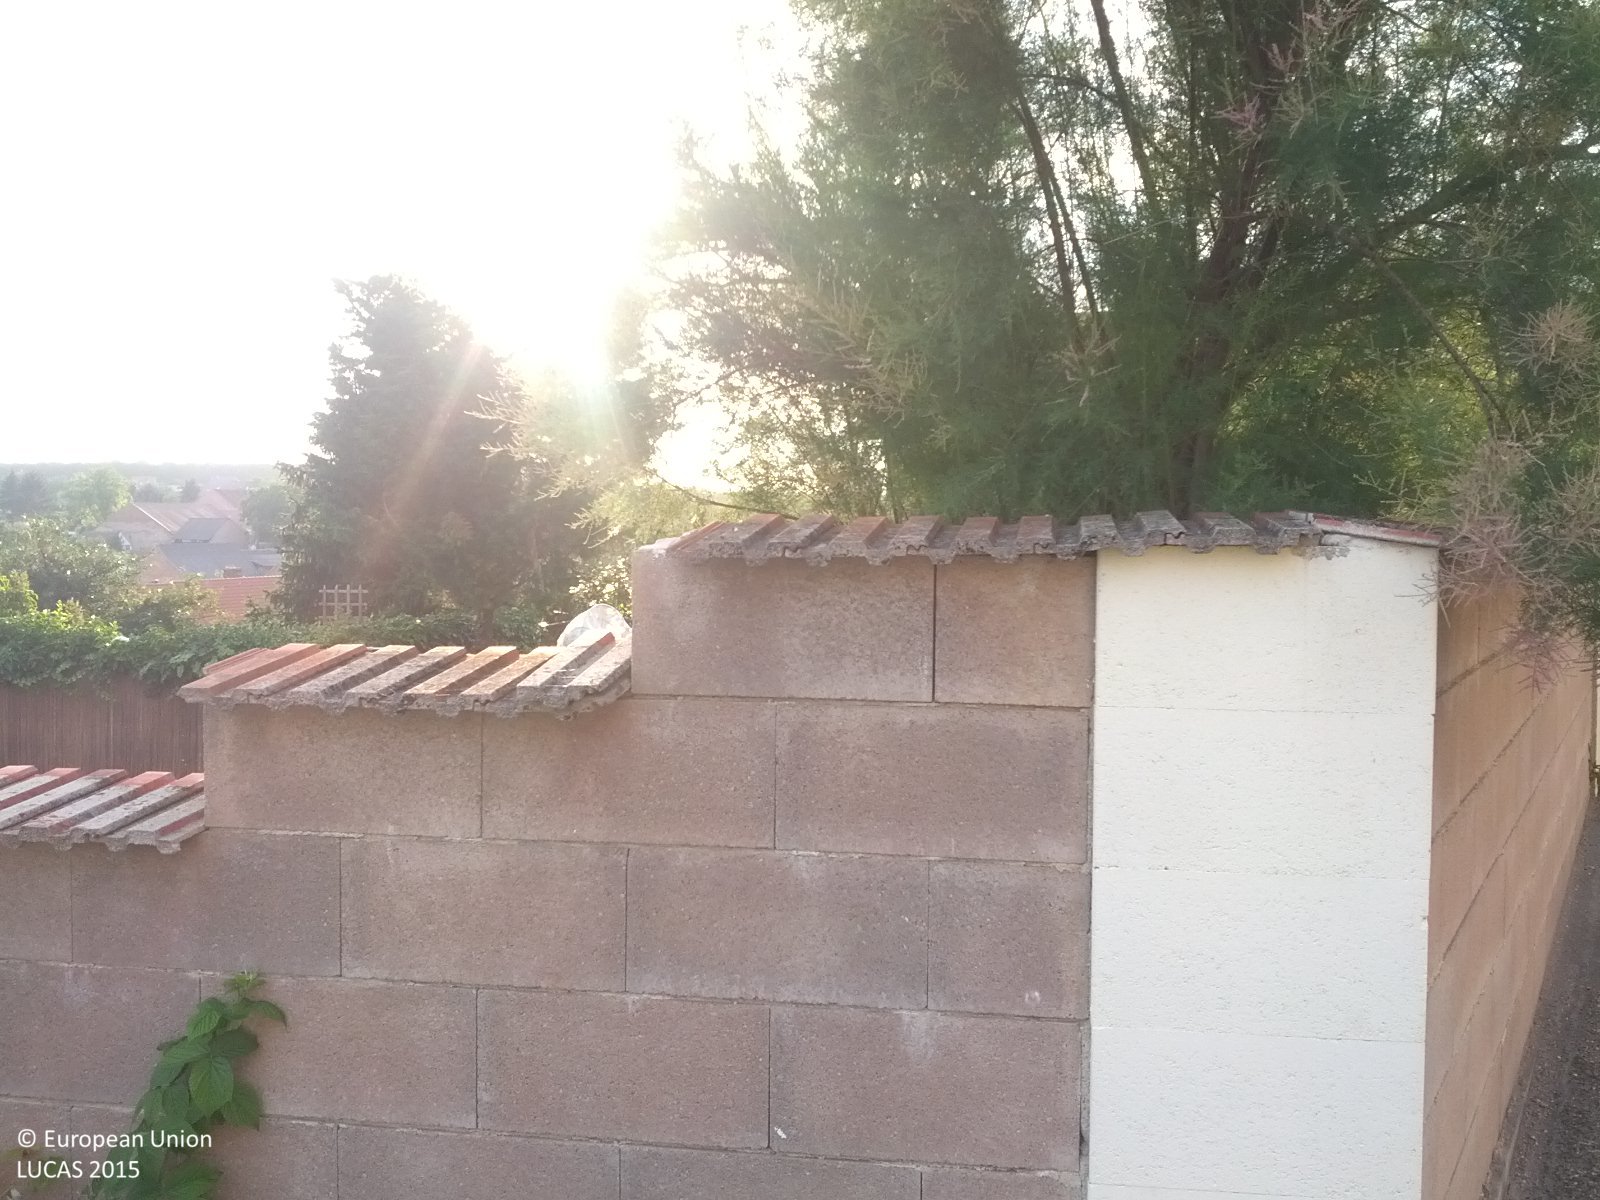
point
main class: Grassland
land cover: Grassland with sparse tree/shrub cover
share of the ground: > 75 %
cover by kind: herbaceous plants 80 %, shrubs 10 %, broadleaved forest trees 5 %, consolidated bare surface 5 %
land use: Residential
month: June
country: AT
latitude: 48.6255
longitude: 16.8319
